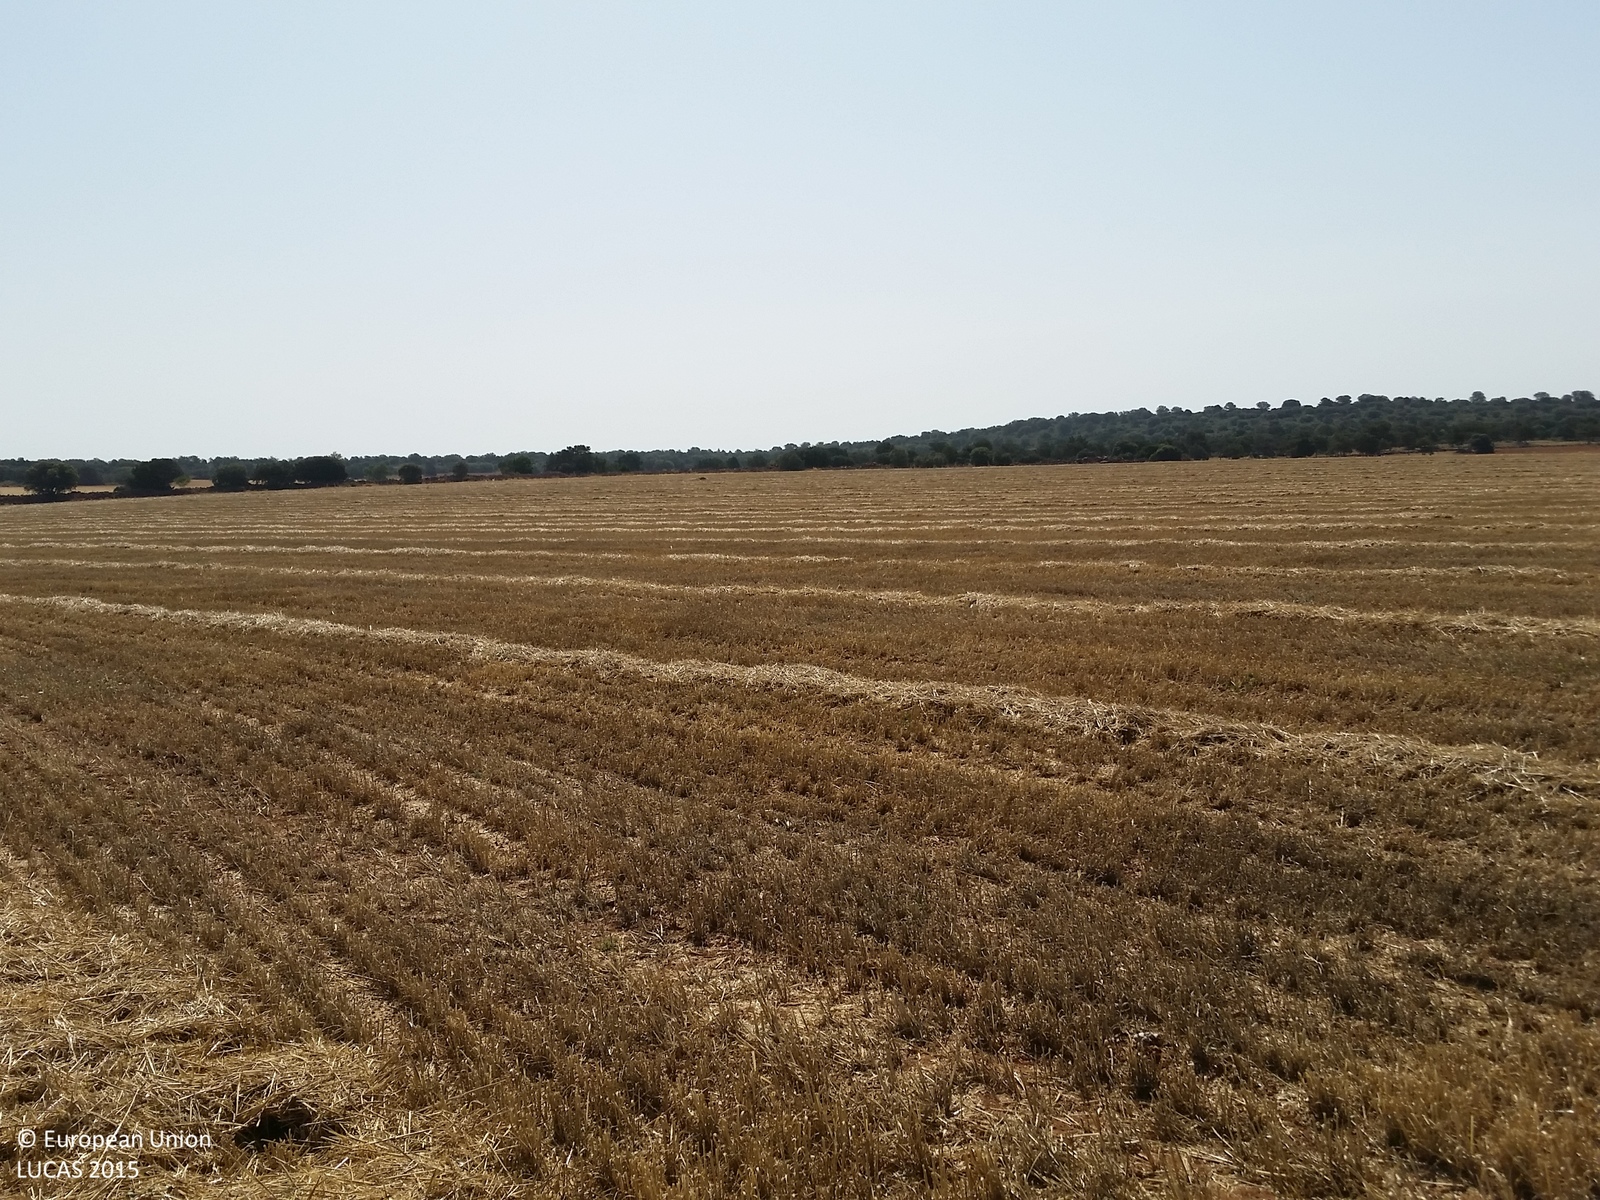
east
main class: Cropland
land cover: Common wheat
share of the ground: < 10 %
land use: Agriculture (excluding fallow land and kitchen gardens)
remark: Harvested field
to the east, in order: Common wheat
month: July
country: ES
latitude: 38.9460
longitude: -2.6868
